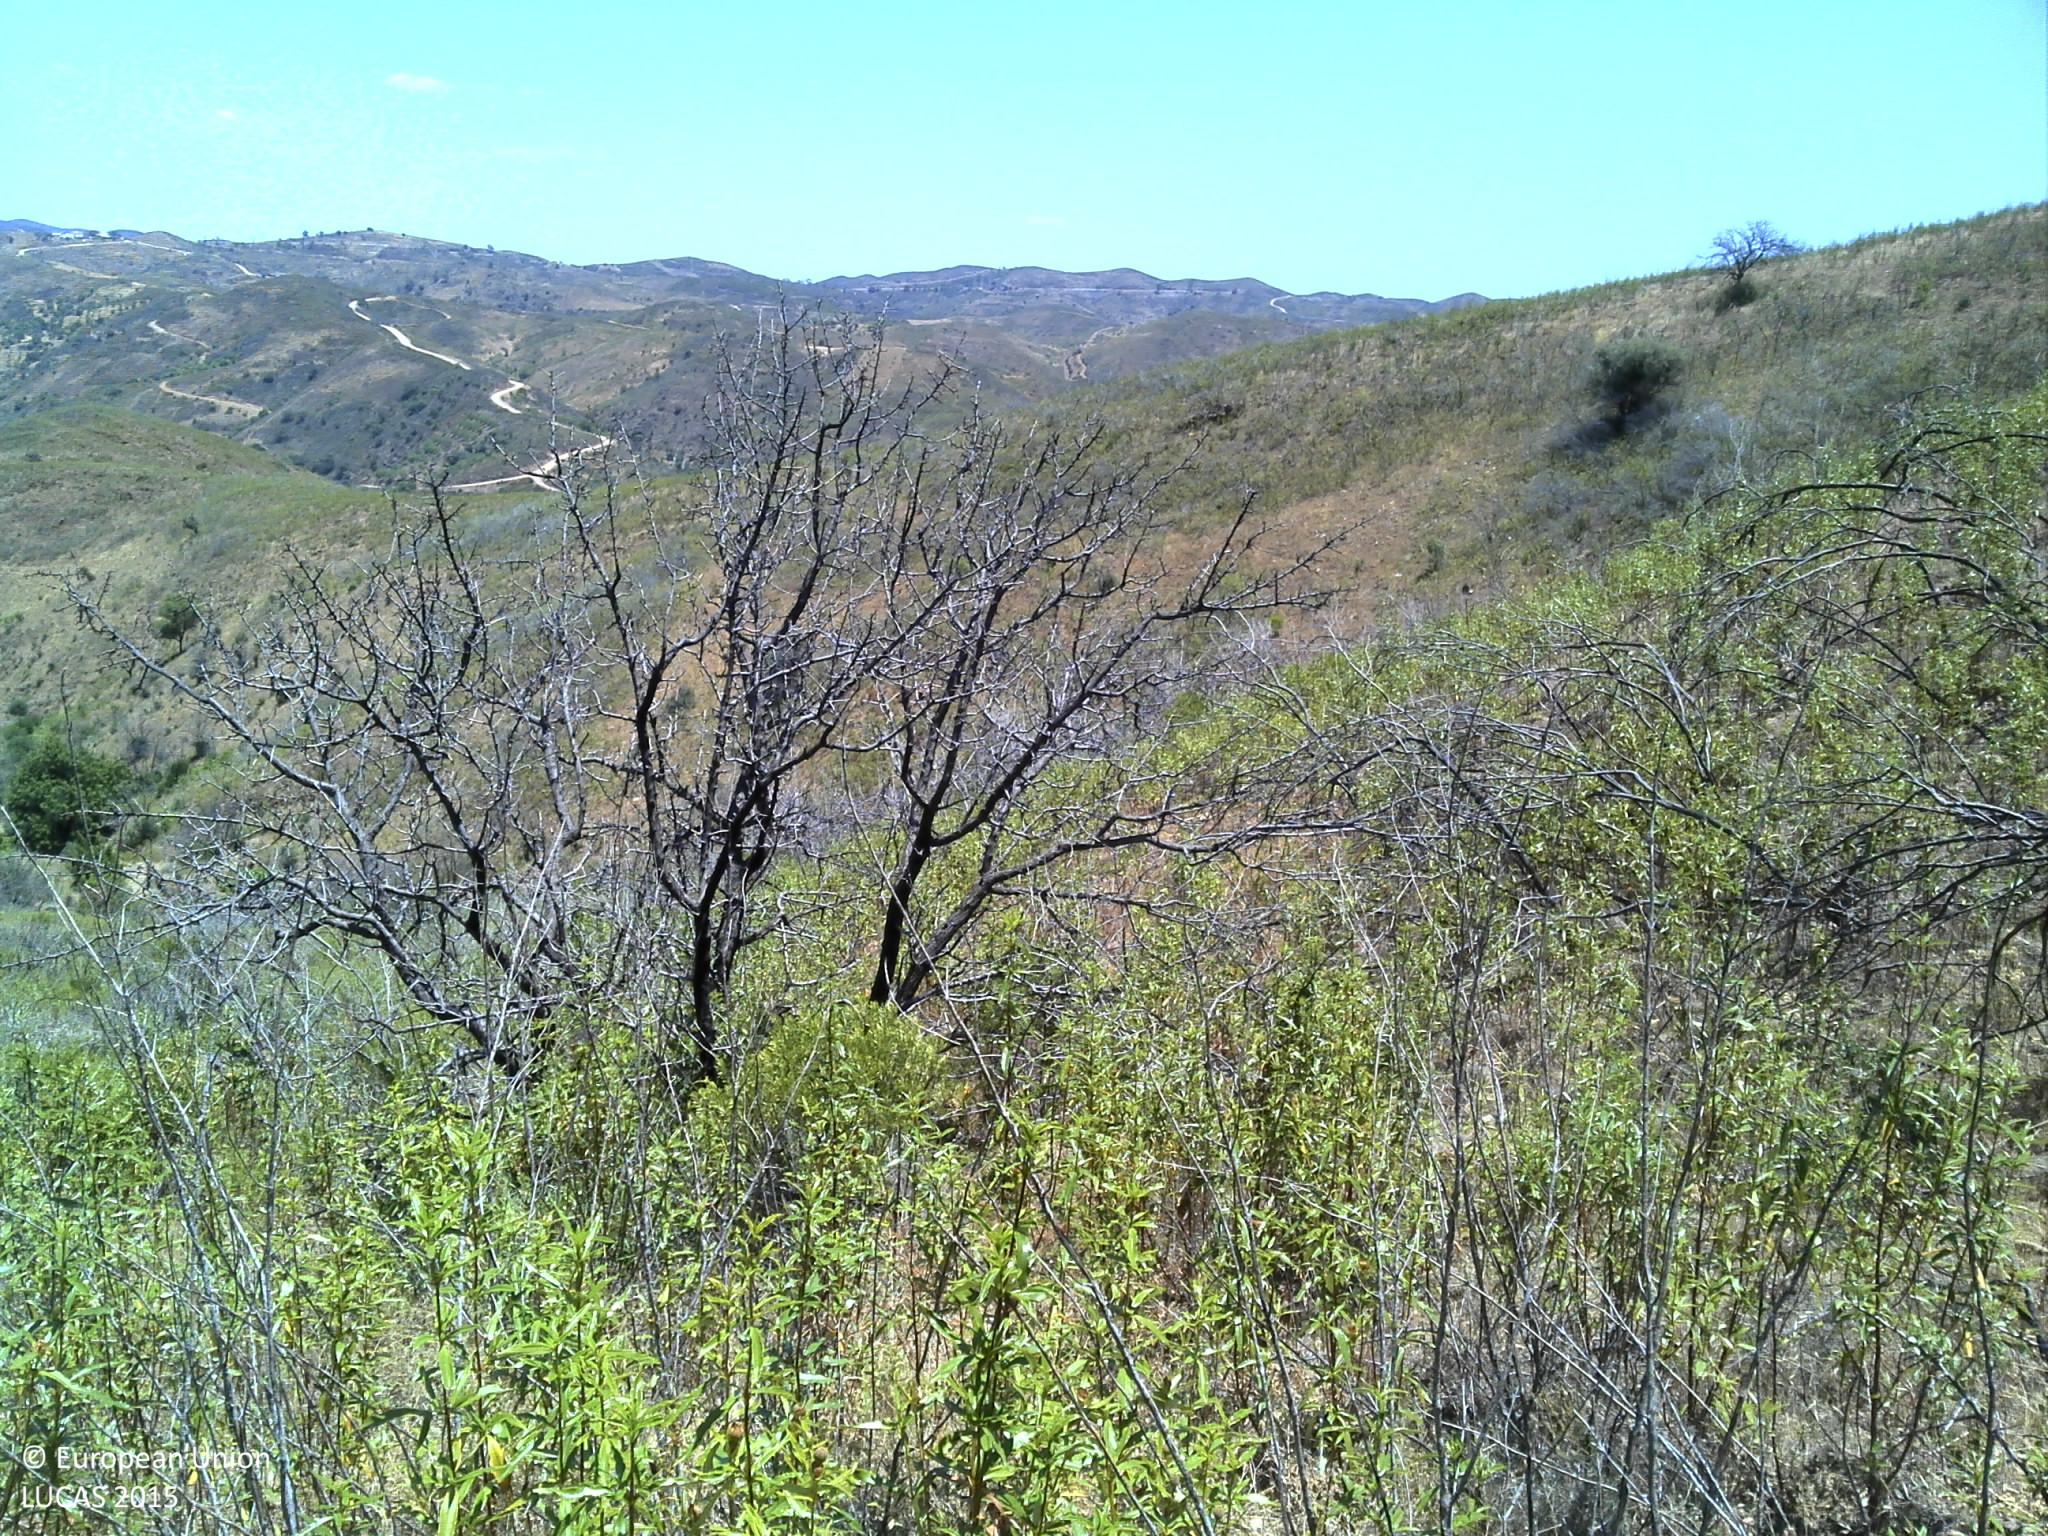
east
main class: Shrubland
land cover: Shrubland without tree cover
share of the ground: 50 - 75 %
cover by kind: shrubs 75 %, unconsolidated bare surface 15 %, herbaceous plants 10 %
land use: Abandoned areas
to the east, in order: Shrubland without tree cover
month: June
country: PT
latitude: 37.1960
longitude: -7.7294
